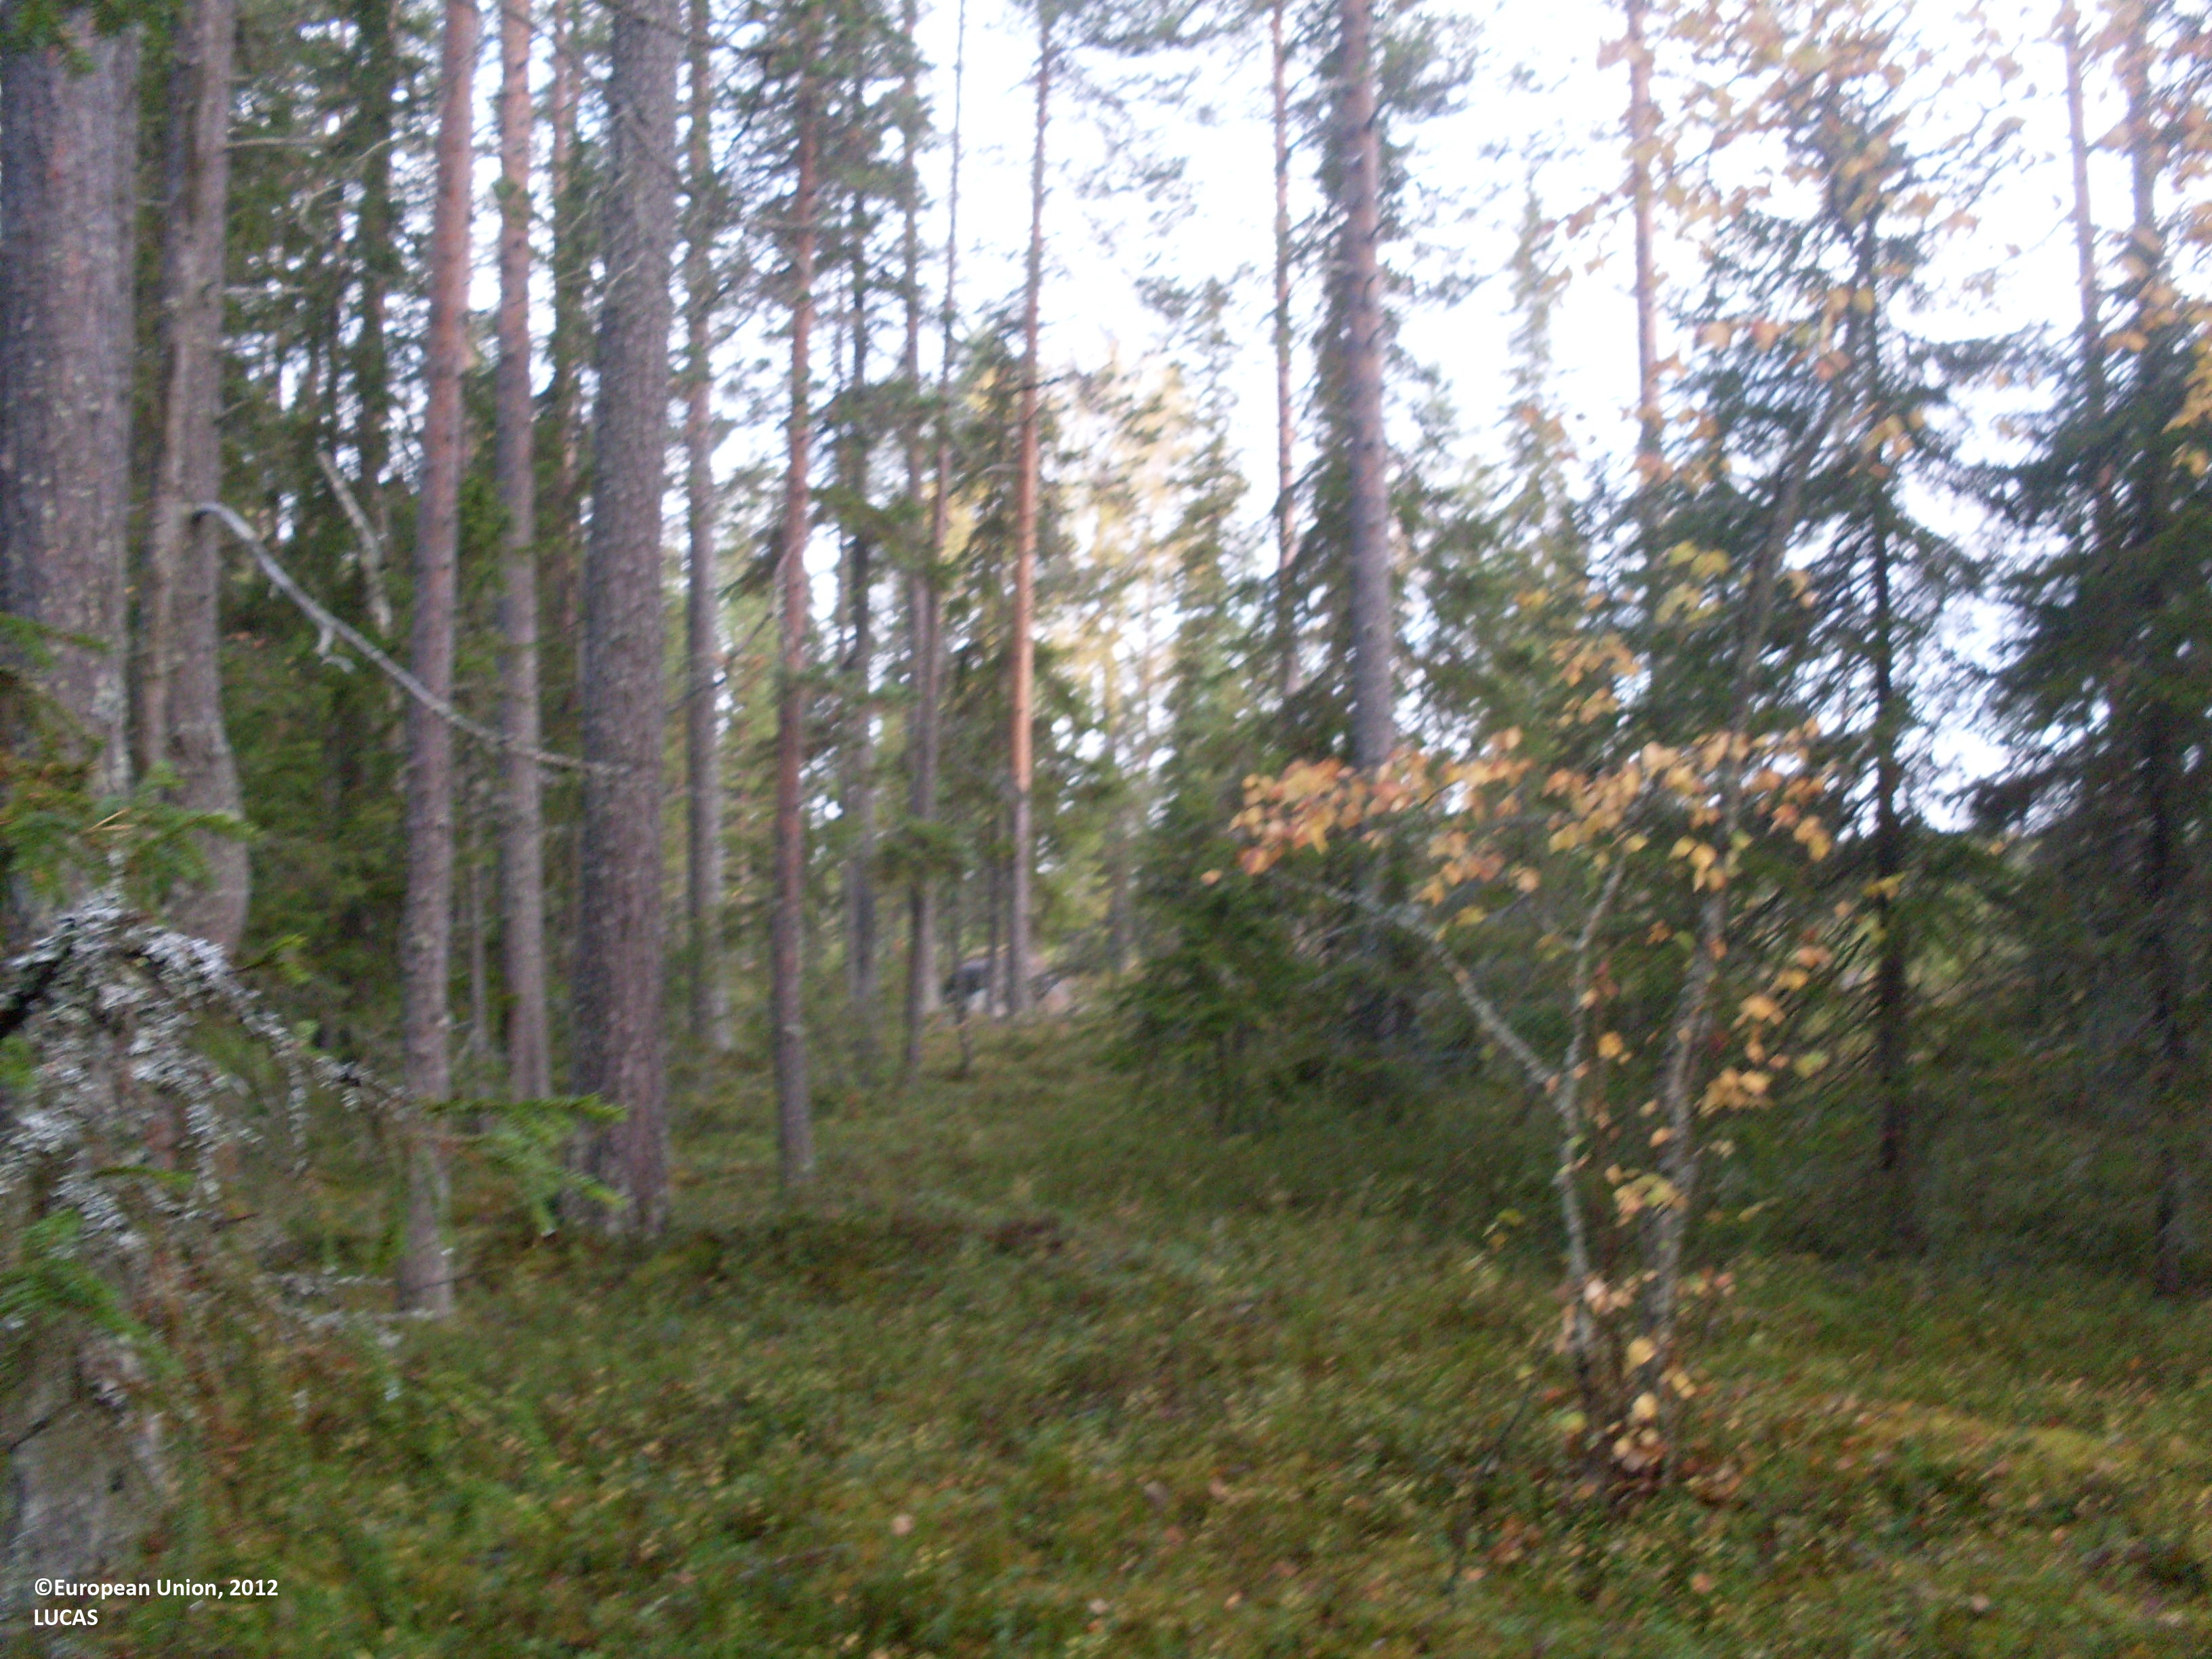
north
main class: Woodland
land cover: Pine dominated mixed woodland
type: boreal forest
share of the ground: 50 - 75 %
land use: Forestry
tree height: > 5 m
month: September
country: FI
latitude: 64.7094
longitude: 29.3151
